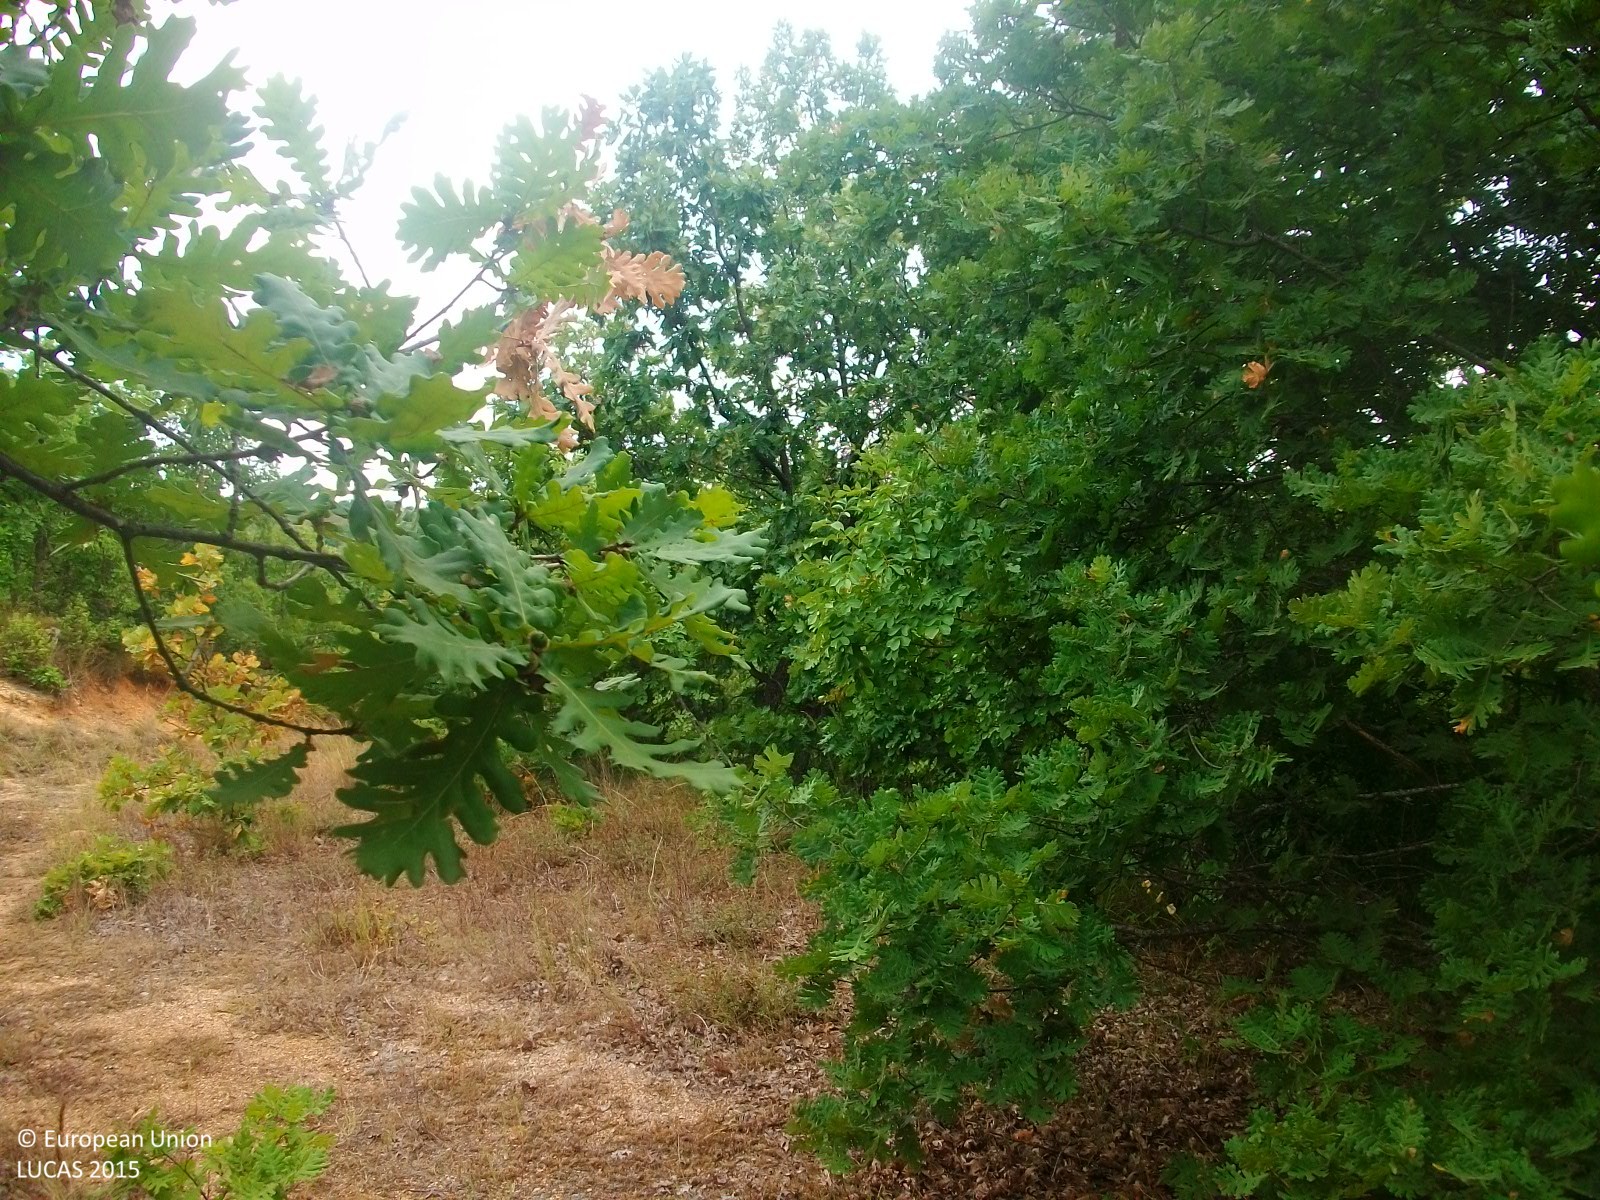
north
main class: Woodland
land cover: Broadleaved woodland
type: thermophilous deciduous forest
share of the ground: > 75 %
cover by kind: broadleaved forest trees 90 %, herbaceous plants 10 %
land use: Forestry
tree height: > 5 m
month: August
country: GR
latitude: 41.3374
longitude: 26.2140
